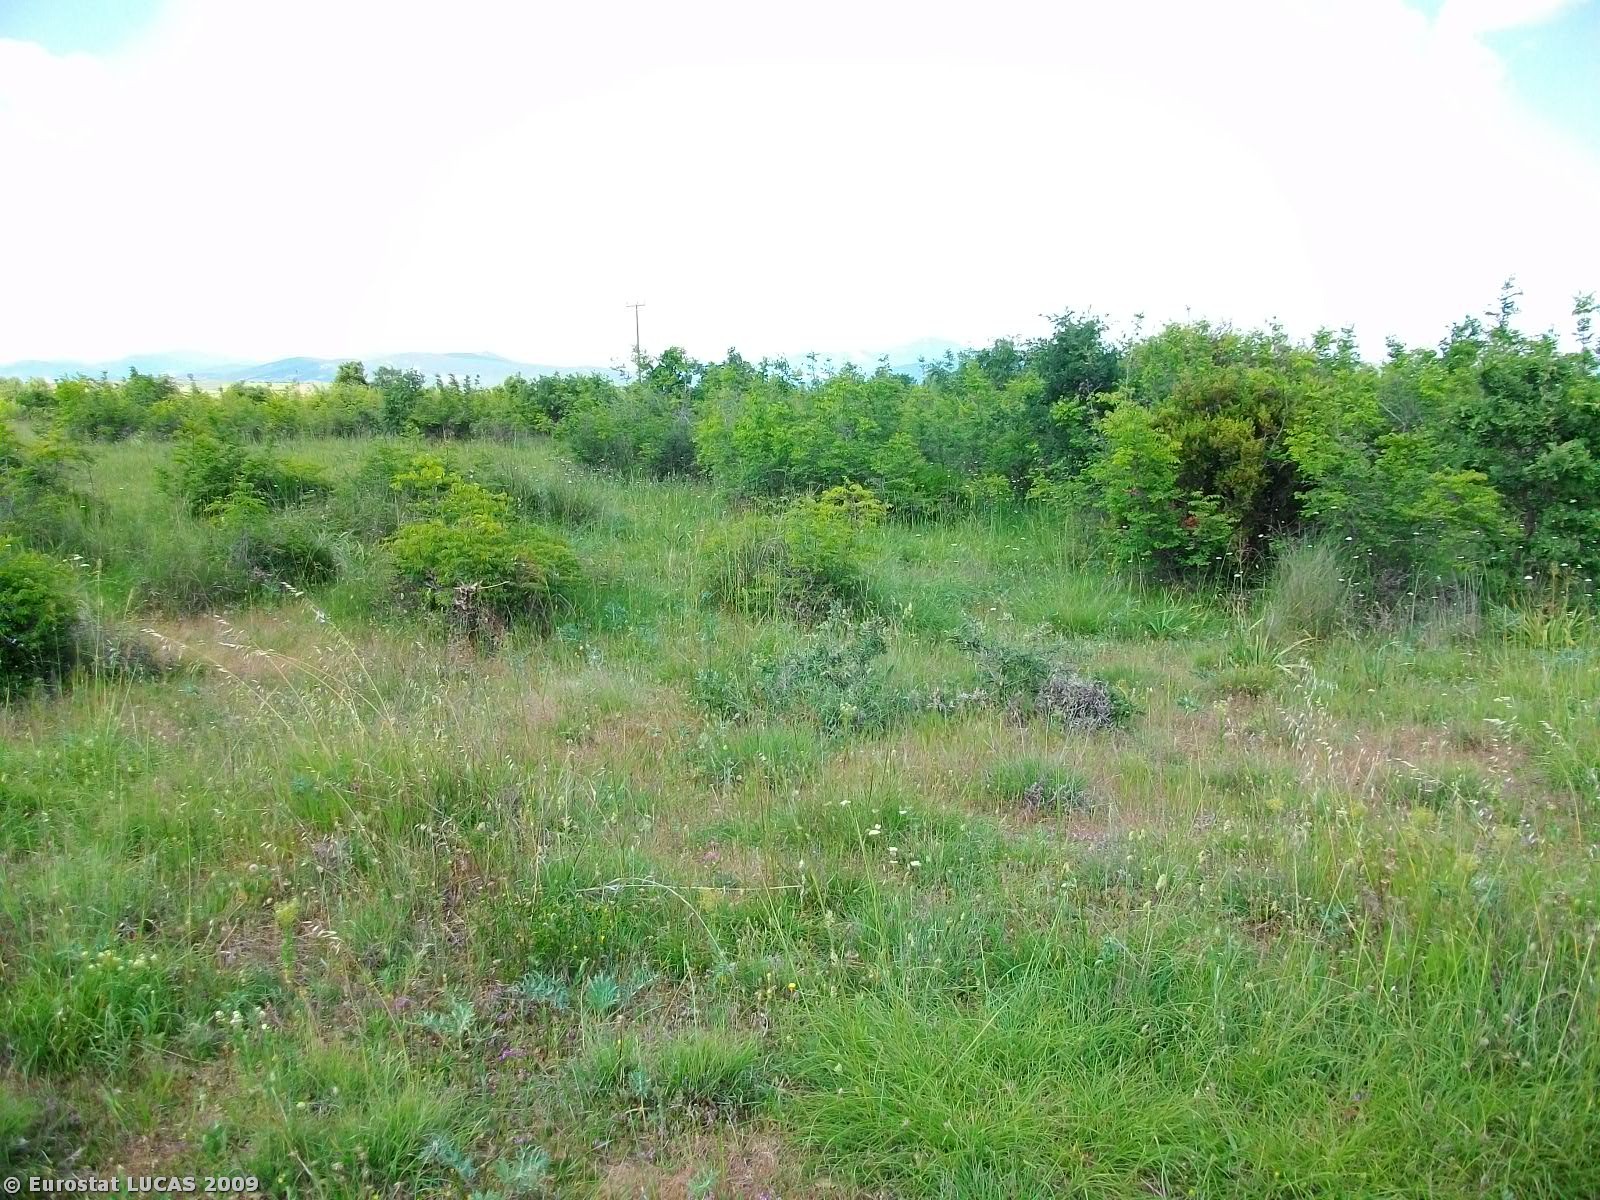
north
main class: Grassland
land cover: Grassland with sparse tree/shrub cover
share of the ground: > 75 %
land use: Unused
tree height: < 5 m
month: May
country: GR
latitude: 41.1005
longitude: 25.5192
